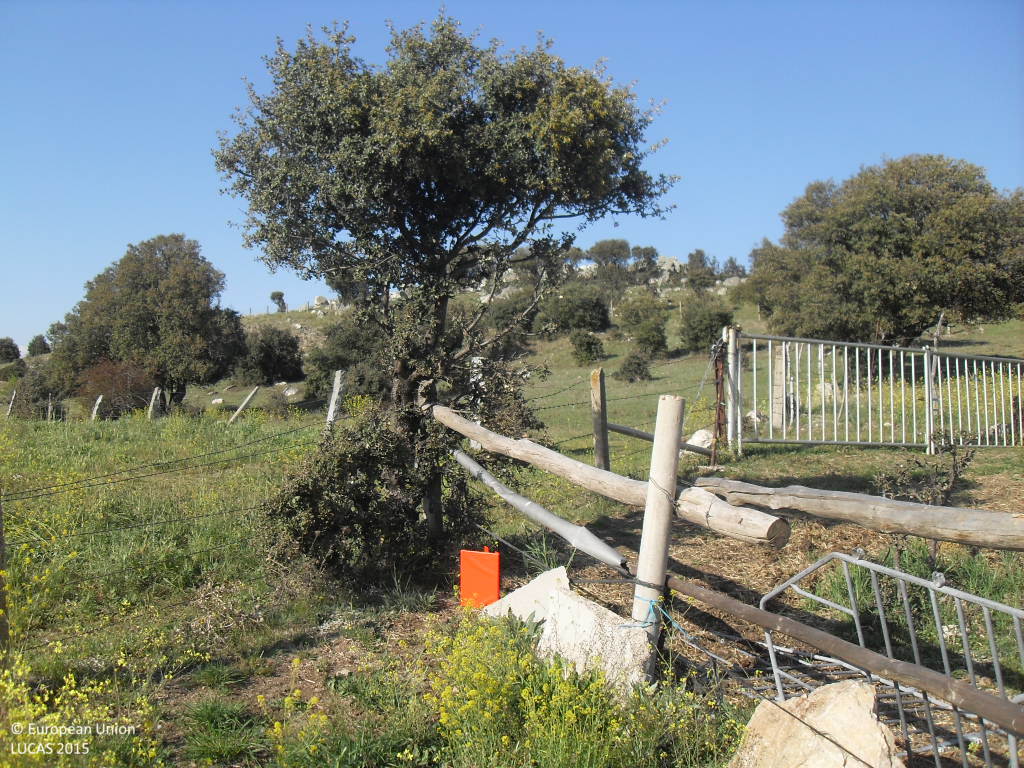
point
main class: Grassland
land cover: Grassland without tree/shrub cover
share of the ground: > 75 %
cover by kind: herbaceous plants 100 %
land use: Agriculture (excluding fallow land and kitchen gardens)
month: April
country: ES
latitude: 40.7125
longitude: -5.3012
